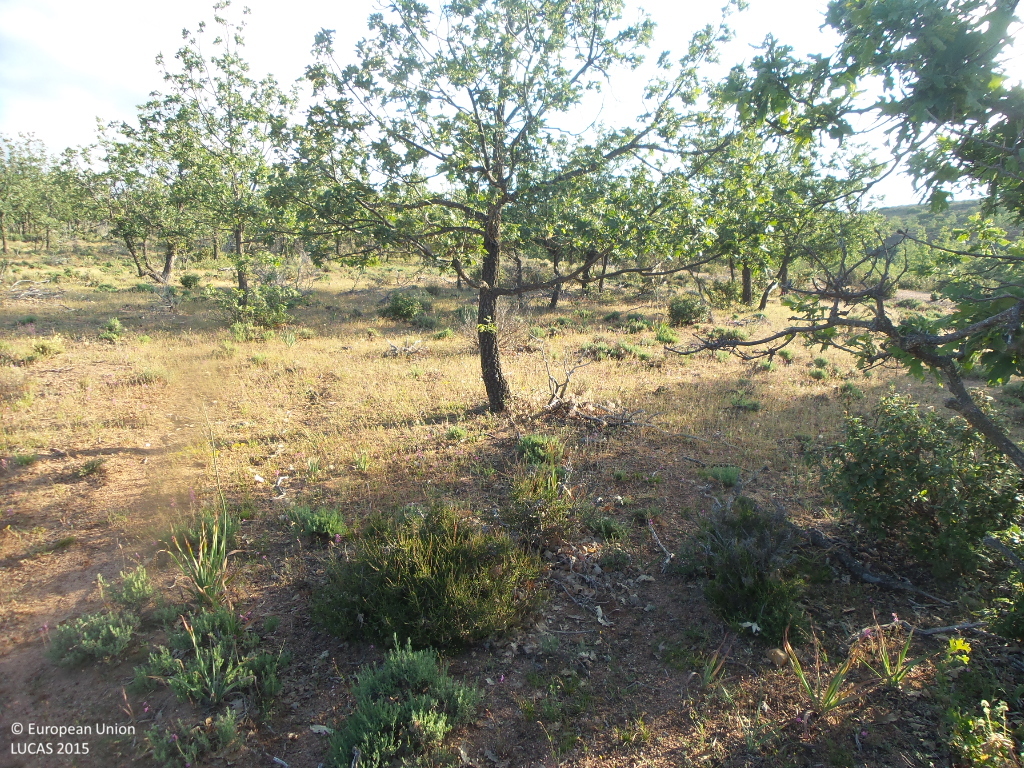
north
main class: Woodland
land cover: Broadleaved woodland
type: thermophilous deciduous forest
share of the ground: 50 - 75 %
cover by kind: broadleaved forest trees 50 %, shrubs 15 %, herbaceous plants 15 %, unconsolidated bare surface 15 %, lichens and mosses 5 %
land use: Semi-natural and natural areas not in use
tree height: < 5 m
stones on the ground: < 10 %
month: June
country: ES
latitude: 41.3032
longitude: -3.1188
